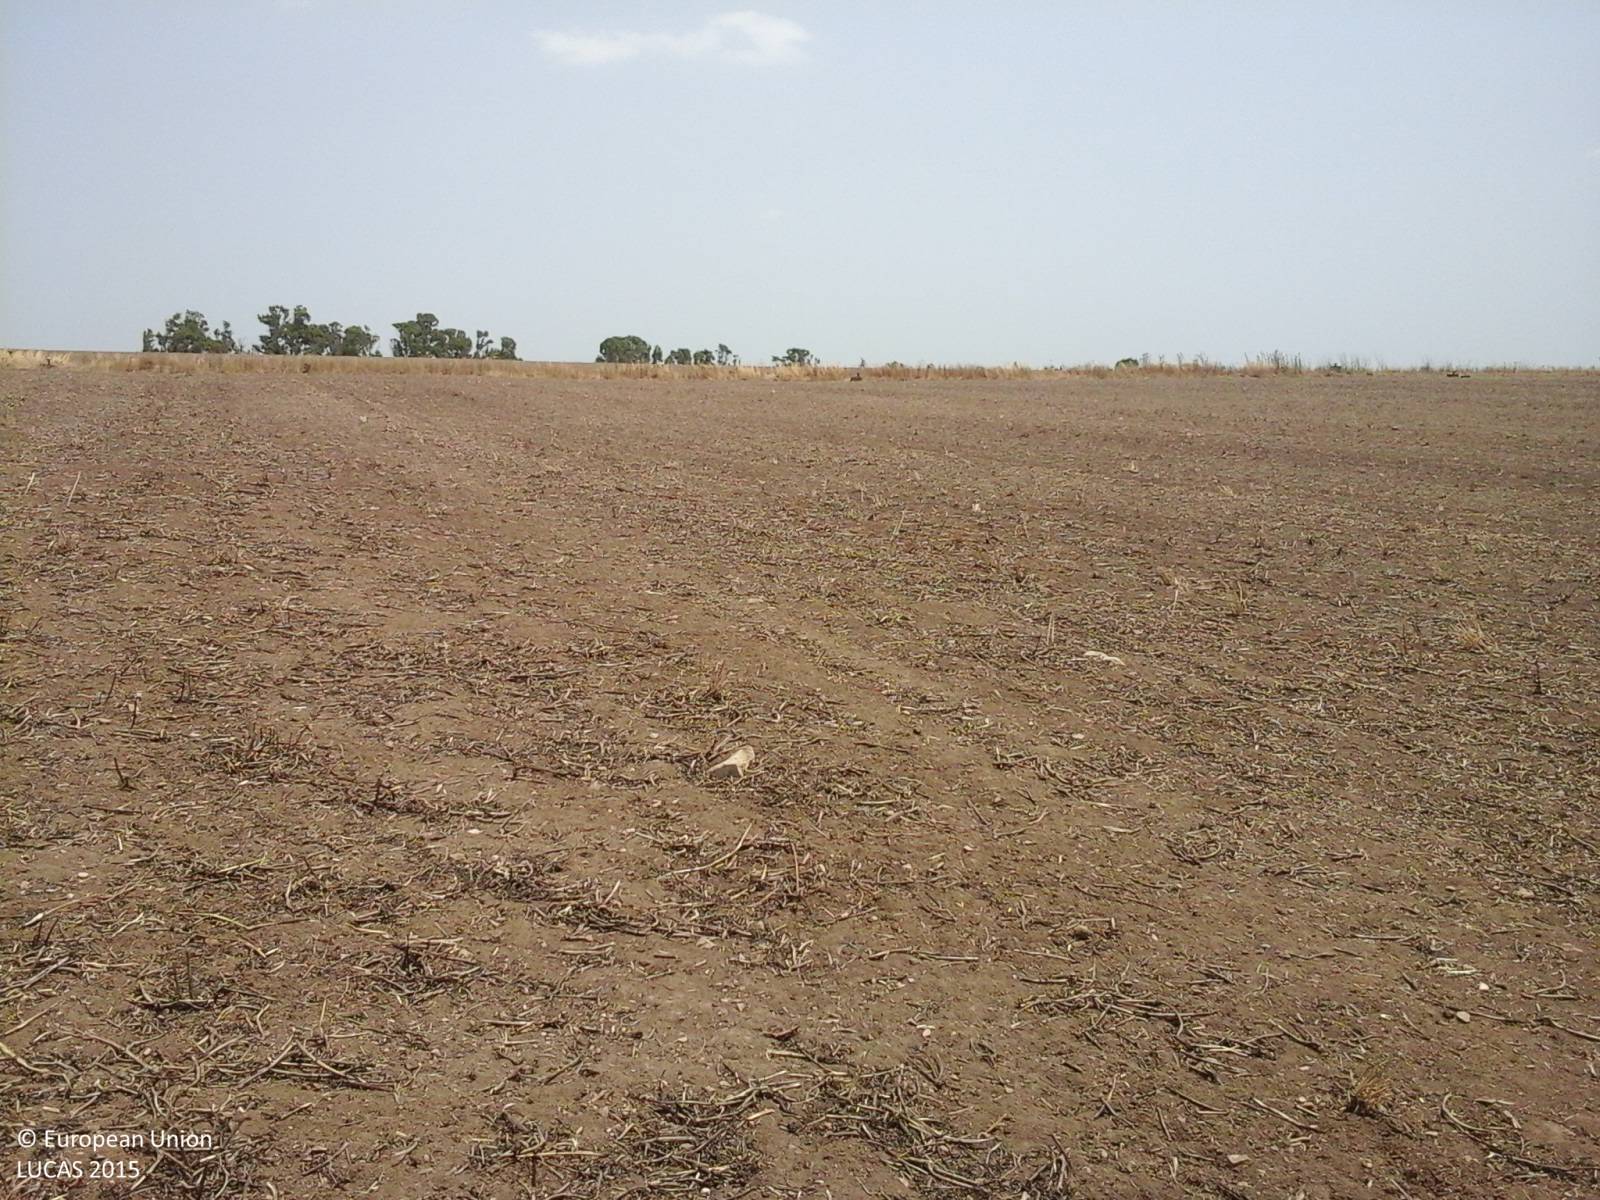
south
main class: Cropland
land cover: Oats
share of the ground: < 10 %
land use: Agriculture (excluding fallow land and kitchen gardens)
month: July
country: IT
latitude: 39.5900
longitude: 8.8076
